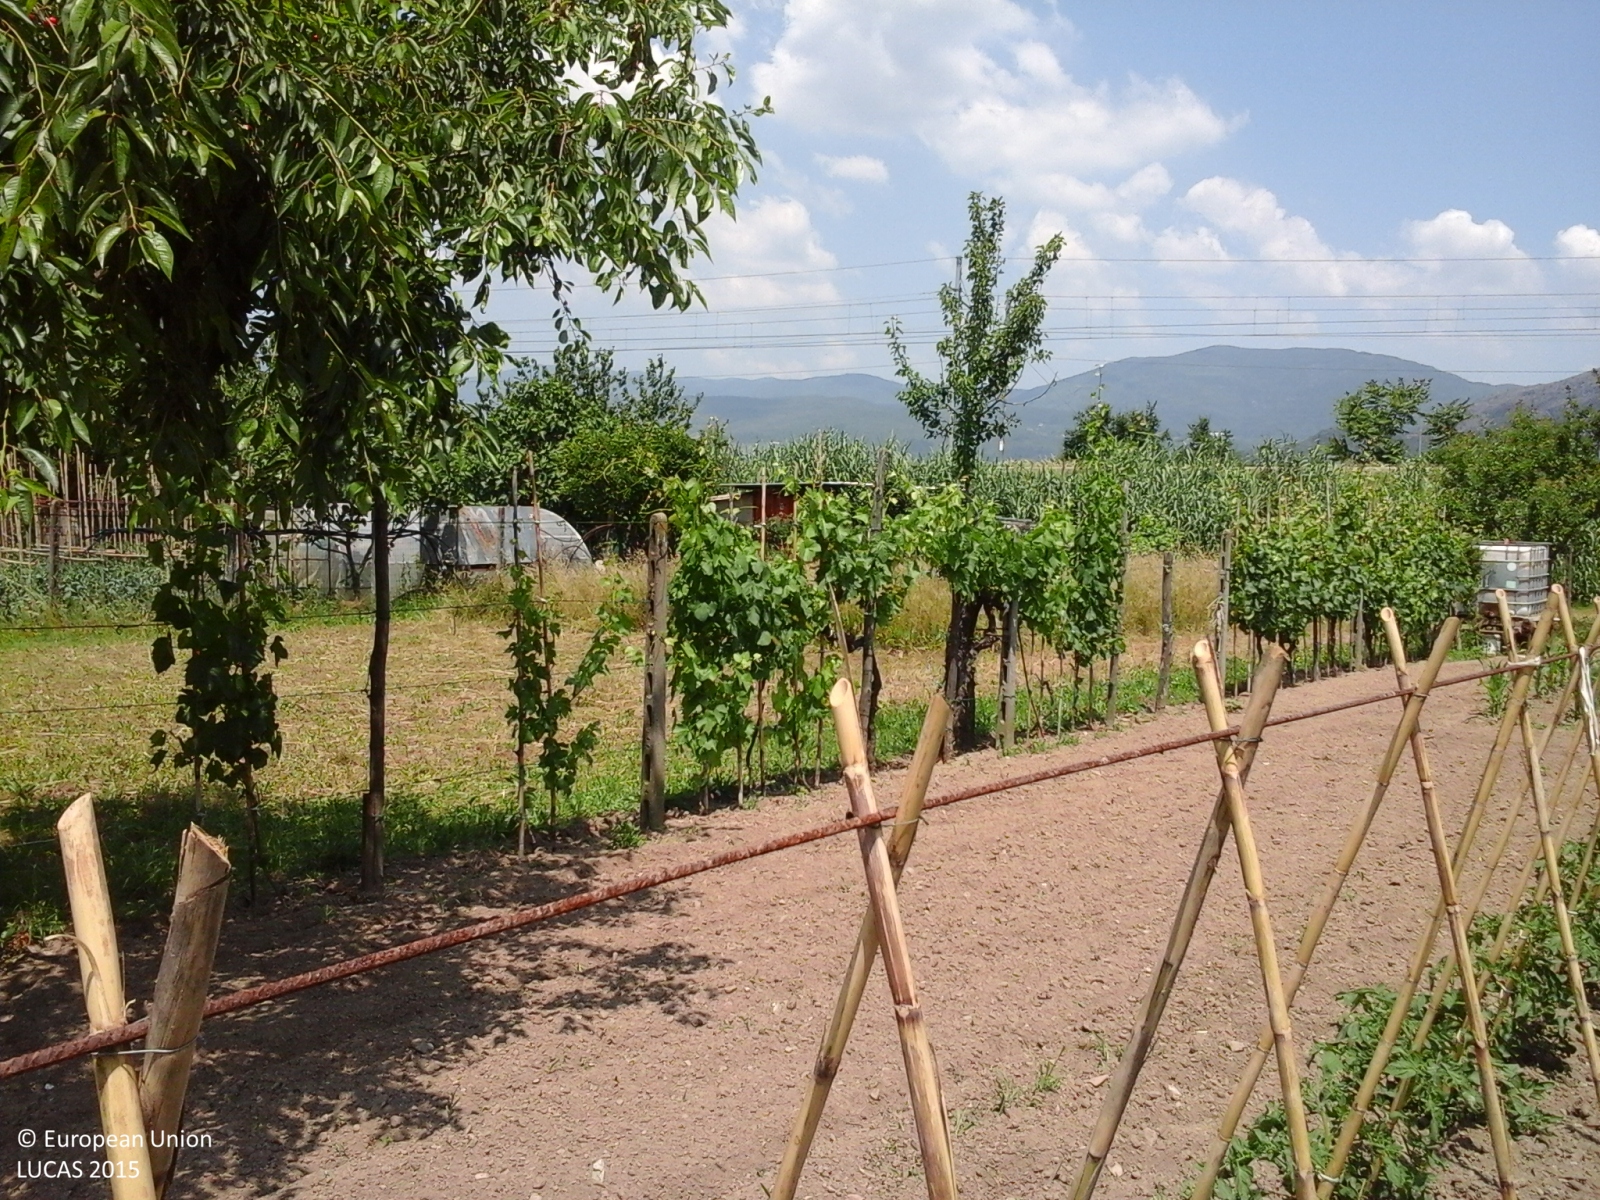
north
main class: Cropland
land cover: Other fresh vegetables
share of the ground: > 75 %
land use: Kitchen garden
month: June
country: IT
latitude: 43.8942
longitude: 11.0555
